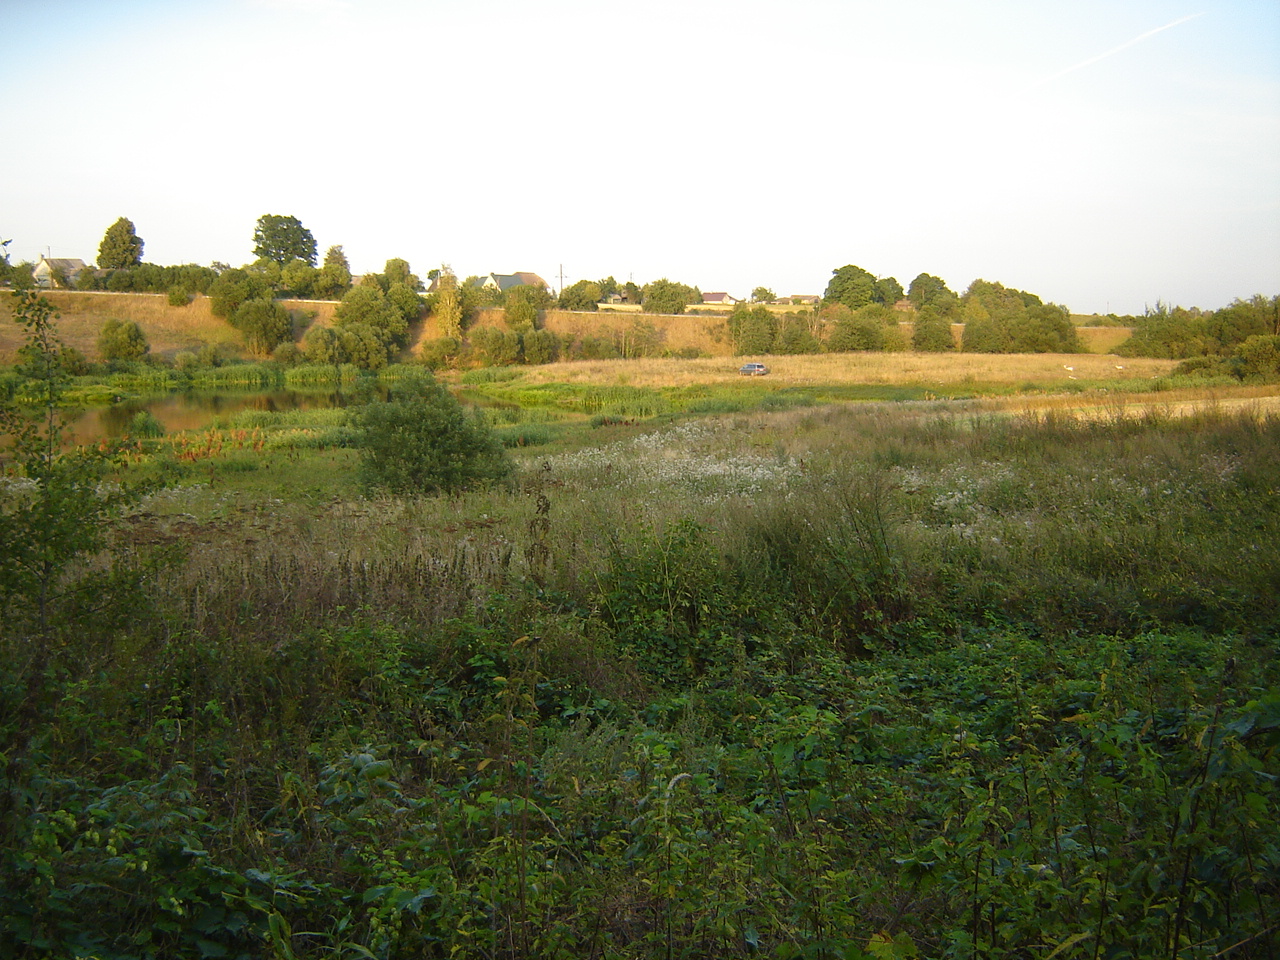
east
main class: Grassland
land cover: Spontaneously vegetated surfaces
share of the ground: > 75 %
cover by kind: herbaceous plants 100 %
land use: Semi-natural and natural areas not in use
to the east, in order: Spontaneously vegetated surfaces; Inland fresh water bodies; Spontaneously vegetated surfaces; Tracks; Spontaneously vegetated surfaces
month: August
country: LT
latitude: 54.7908
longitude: 24.8062
